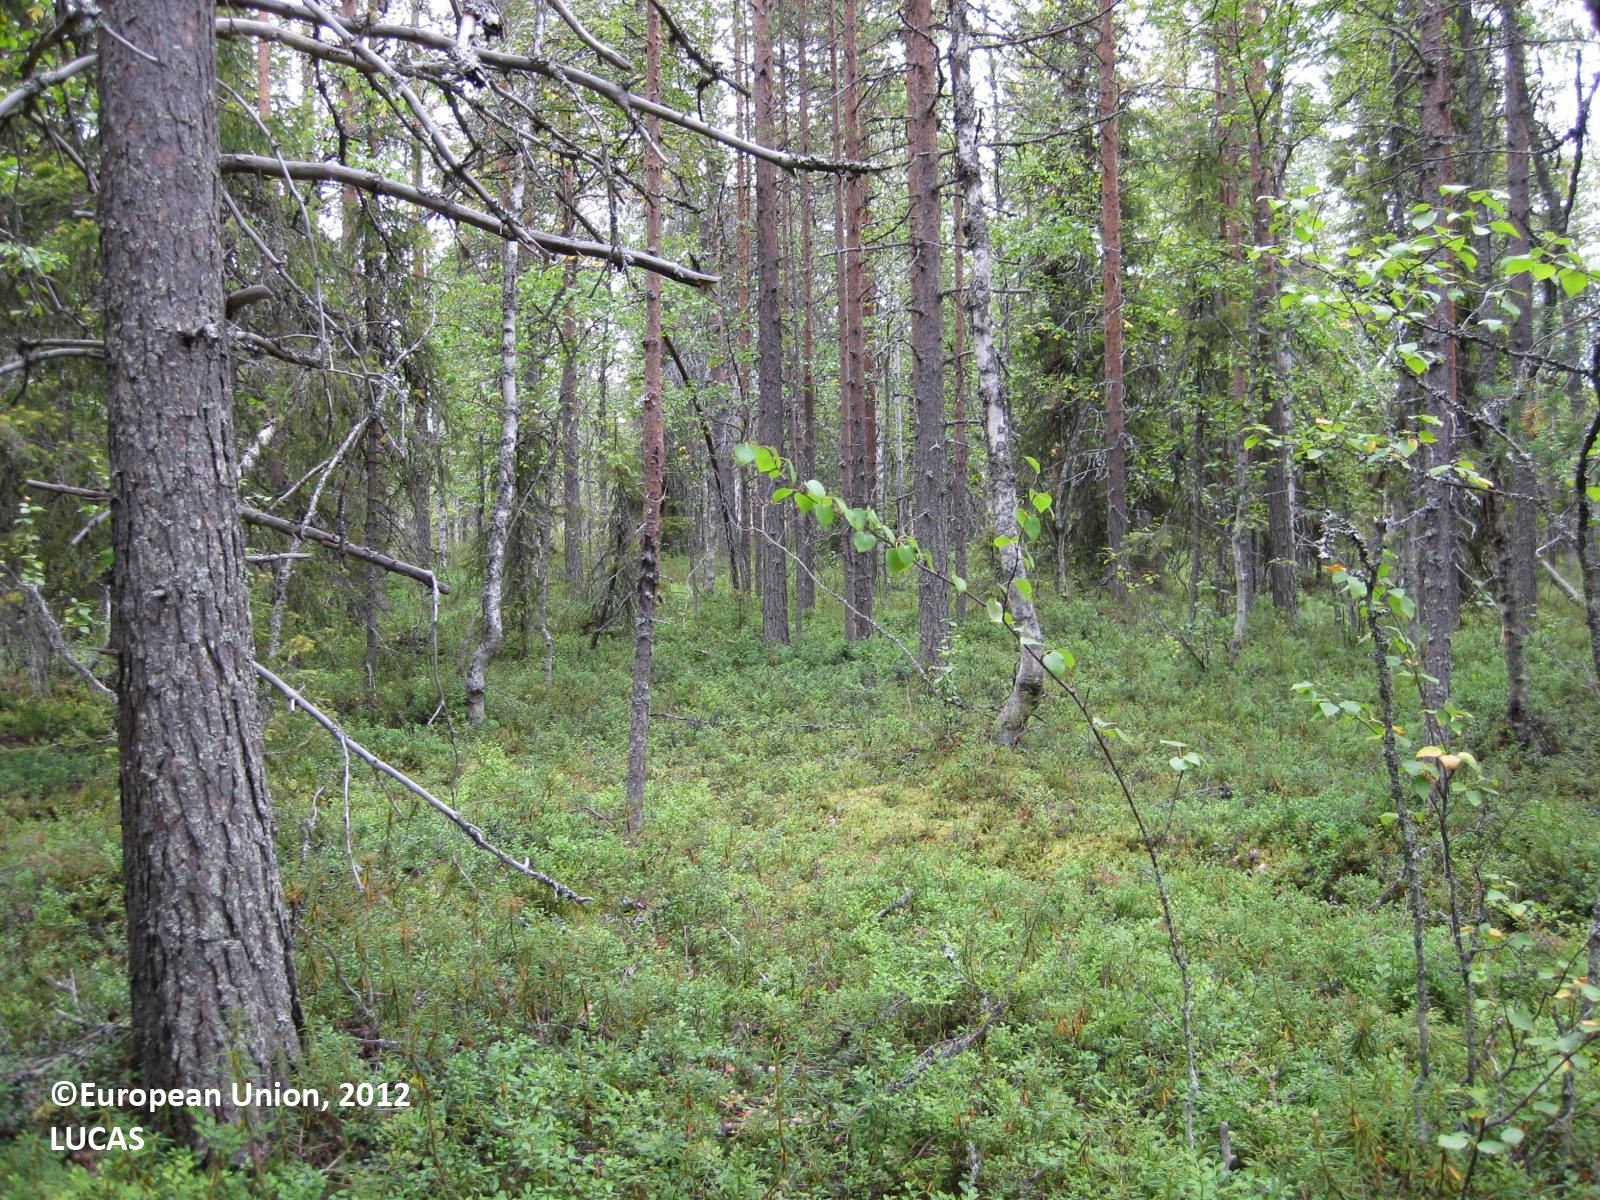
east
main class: Woodland
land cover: Pine dominated mixed woodland
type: boreal forest
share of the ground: 50 - 75 %
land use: Forestry
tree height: > 5 m
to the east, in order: Pine dominated mixed woodland; Artificial constructions in urban areas; Pine dominated mixed woodland; Spontaneously vegetated surfaces; Ditches and canals; Spontaneously vegetated surfaces; Paved roads, cycling and walking lanes; Spontaneously vegetated surfaces; Ditches and canals; Artificial constructions in urban areas
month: August
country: FI
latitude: 66.2839
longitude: 28.8556
